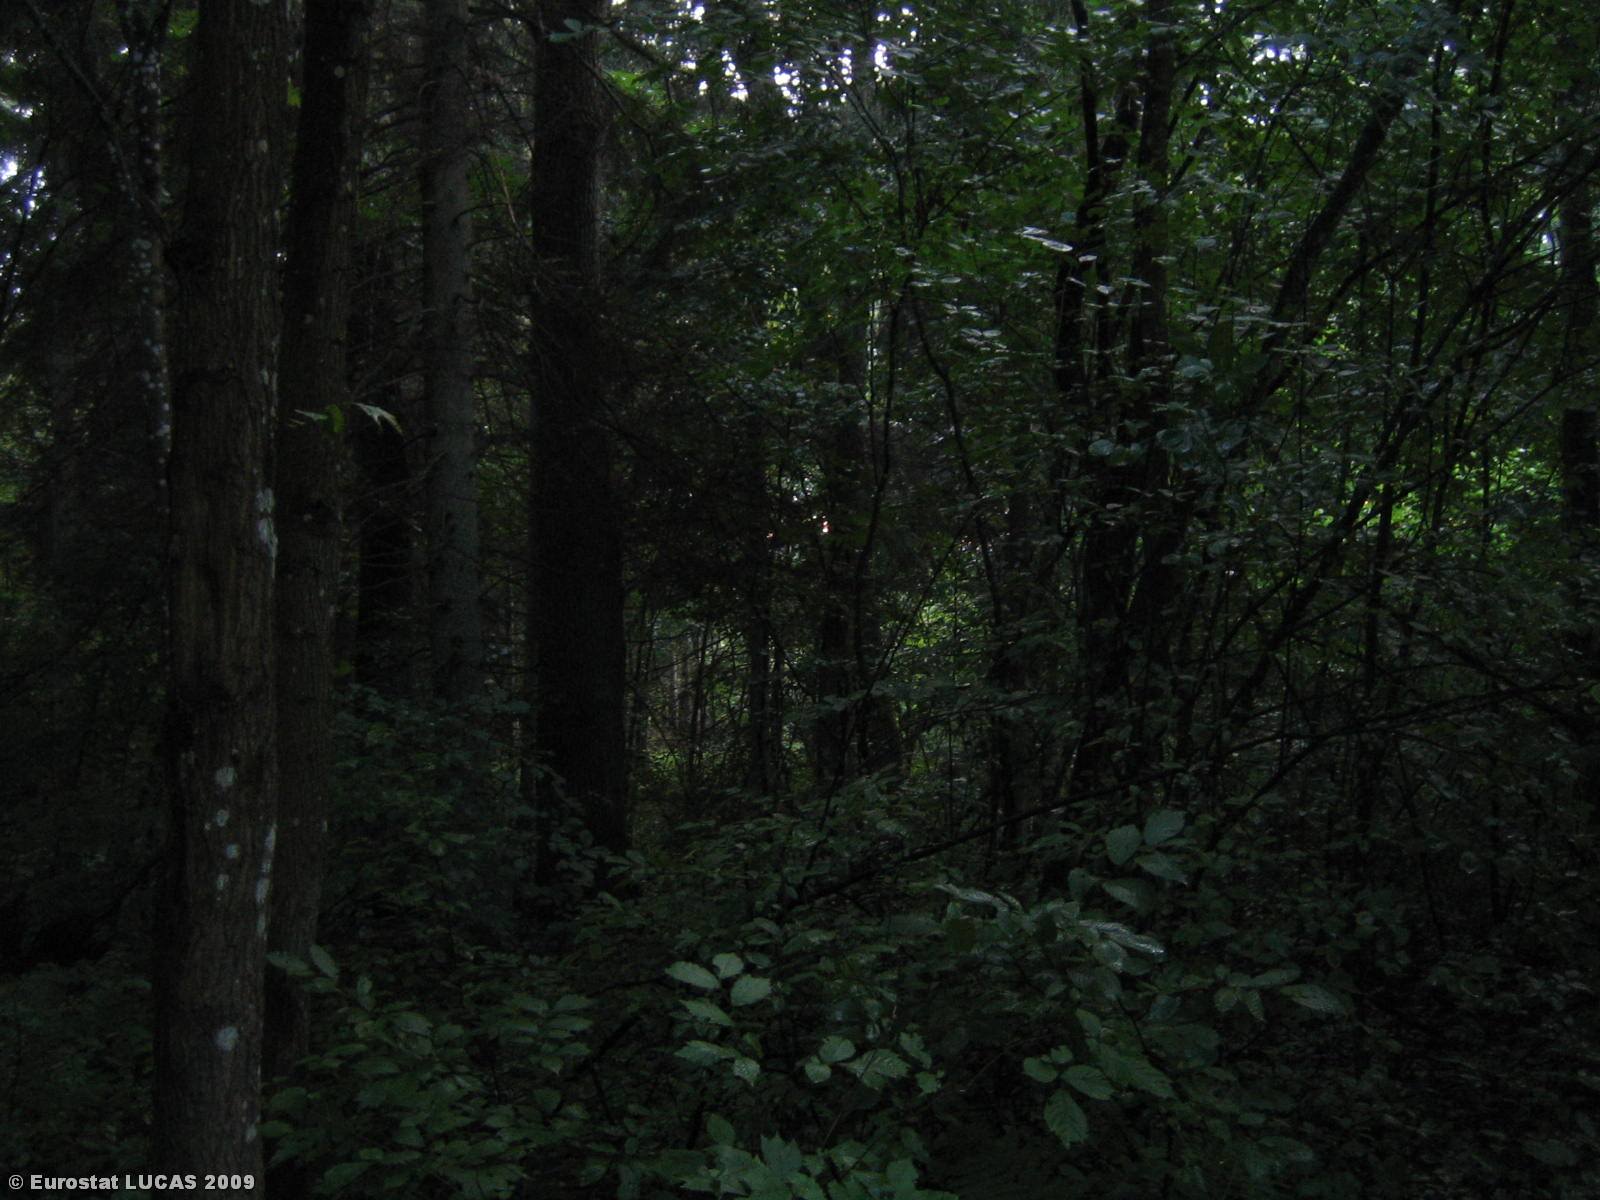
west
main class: Woodland
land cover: Mixed woodland
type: hemiboreal forest and nemoral coniferous forest and mixed broadleaved-coniferous forest
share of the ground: > 75 %
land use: Forestry
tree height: > 5 m
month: August
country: LT
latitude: 54.6790
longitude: 24.6697
